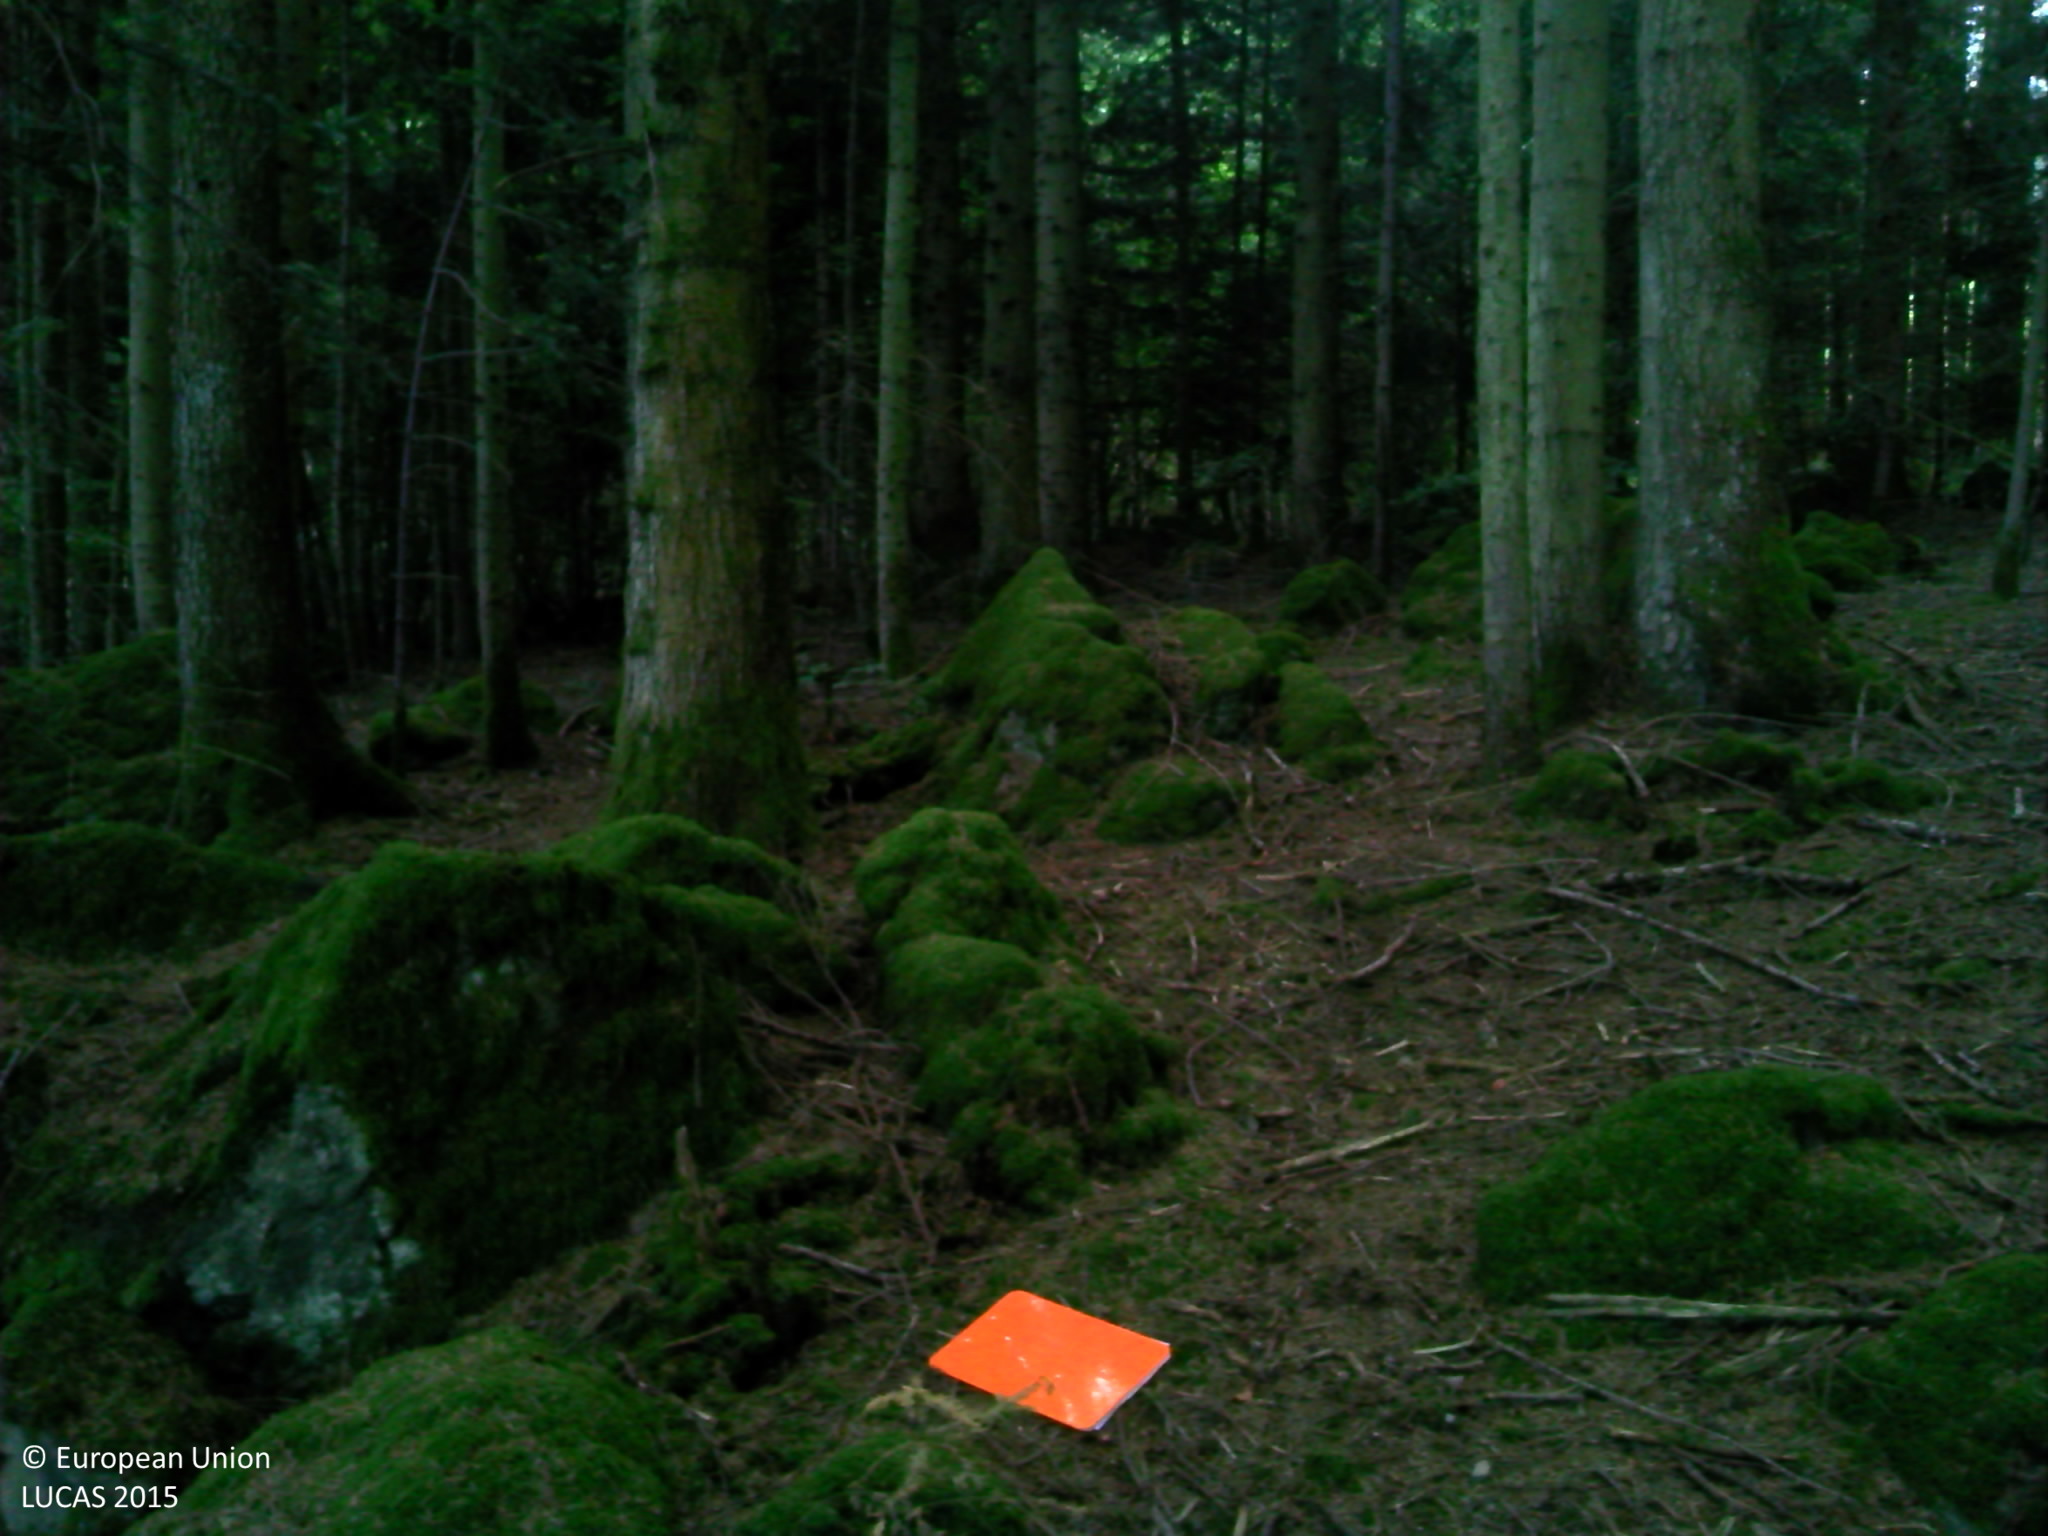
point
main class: Woodland
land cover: Spruce dominated coniferous woodland
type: alpine coniferous forest
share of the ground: > 75 %
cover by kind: coniferous forest trees 100 %
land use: Forestry
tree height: > 5 m
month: August
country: FR
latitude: 46.2273
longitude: 4.4916
